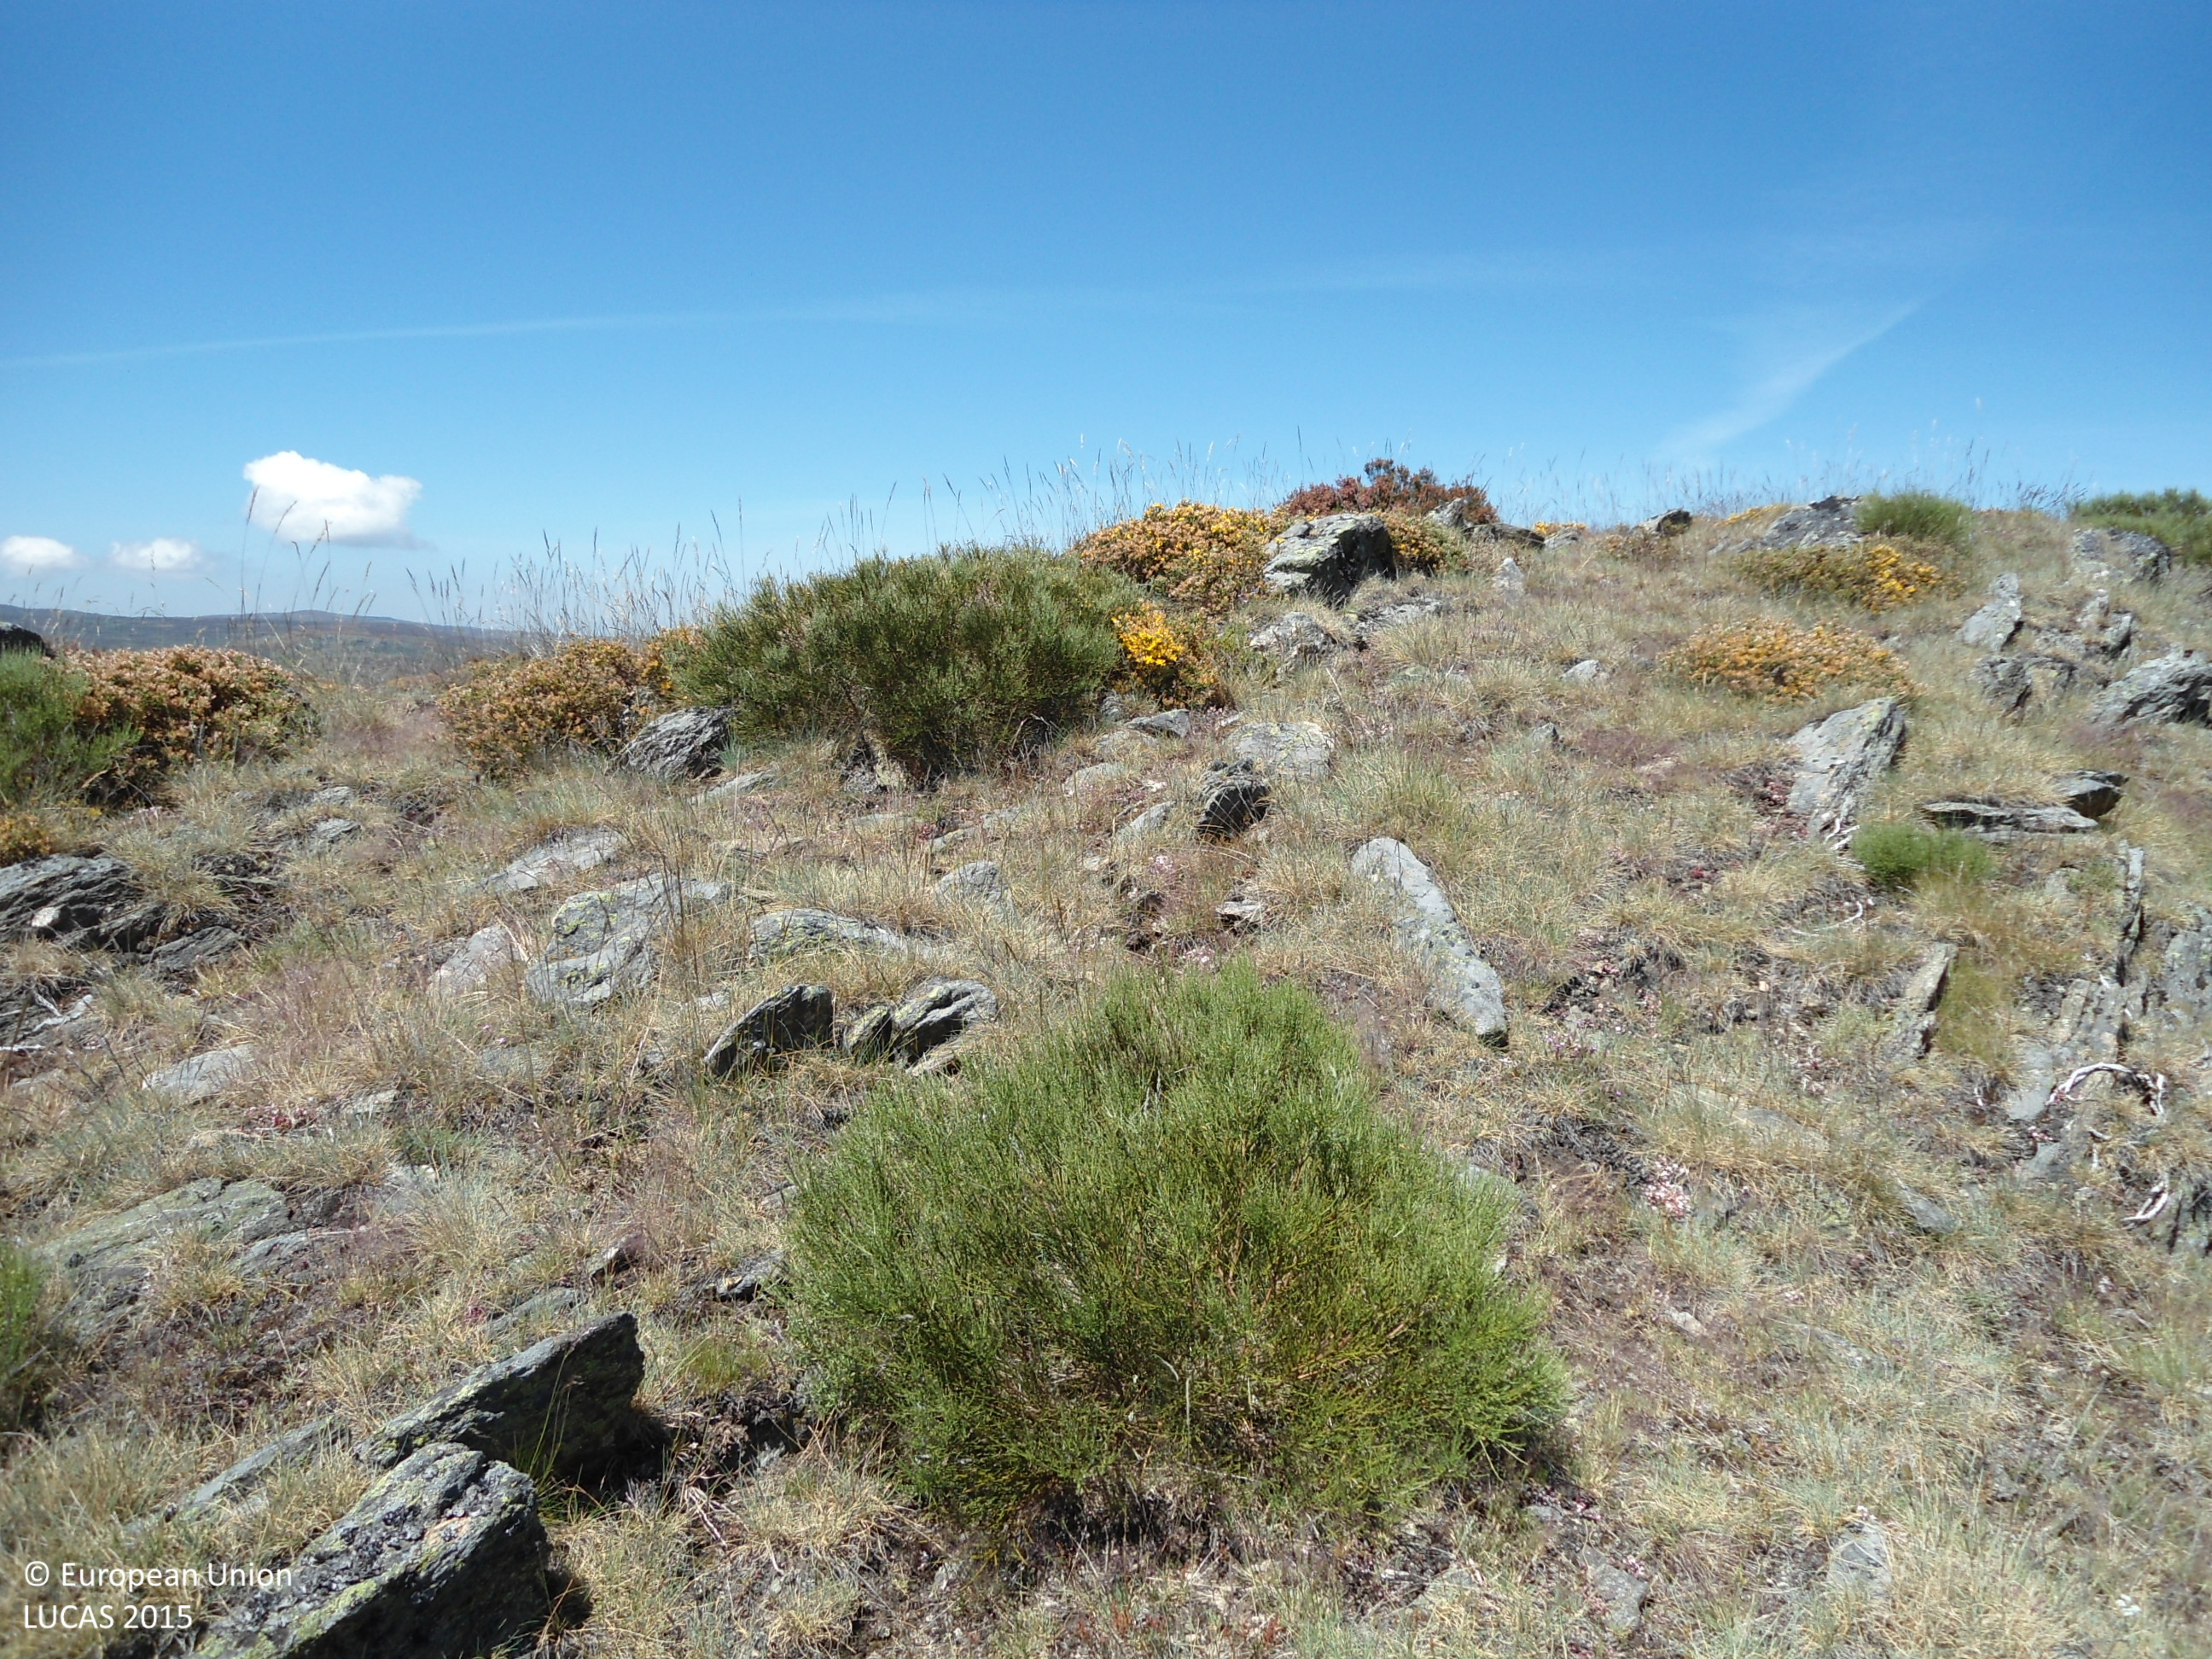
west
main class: Shrubland
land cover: Shrubland without tree cover
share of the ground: > 75 %
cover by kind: shrubs 90 %, consolidated bare surface 10 %
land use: Community services
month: June
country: ES
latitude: 42.1618
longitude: -6.7854
